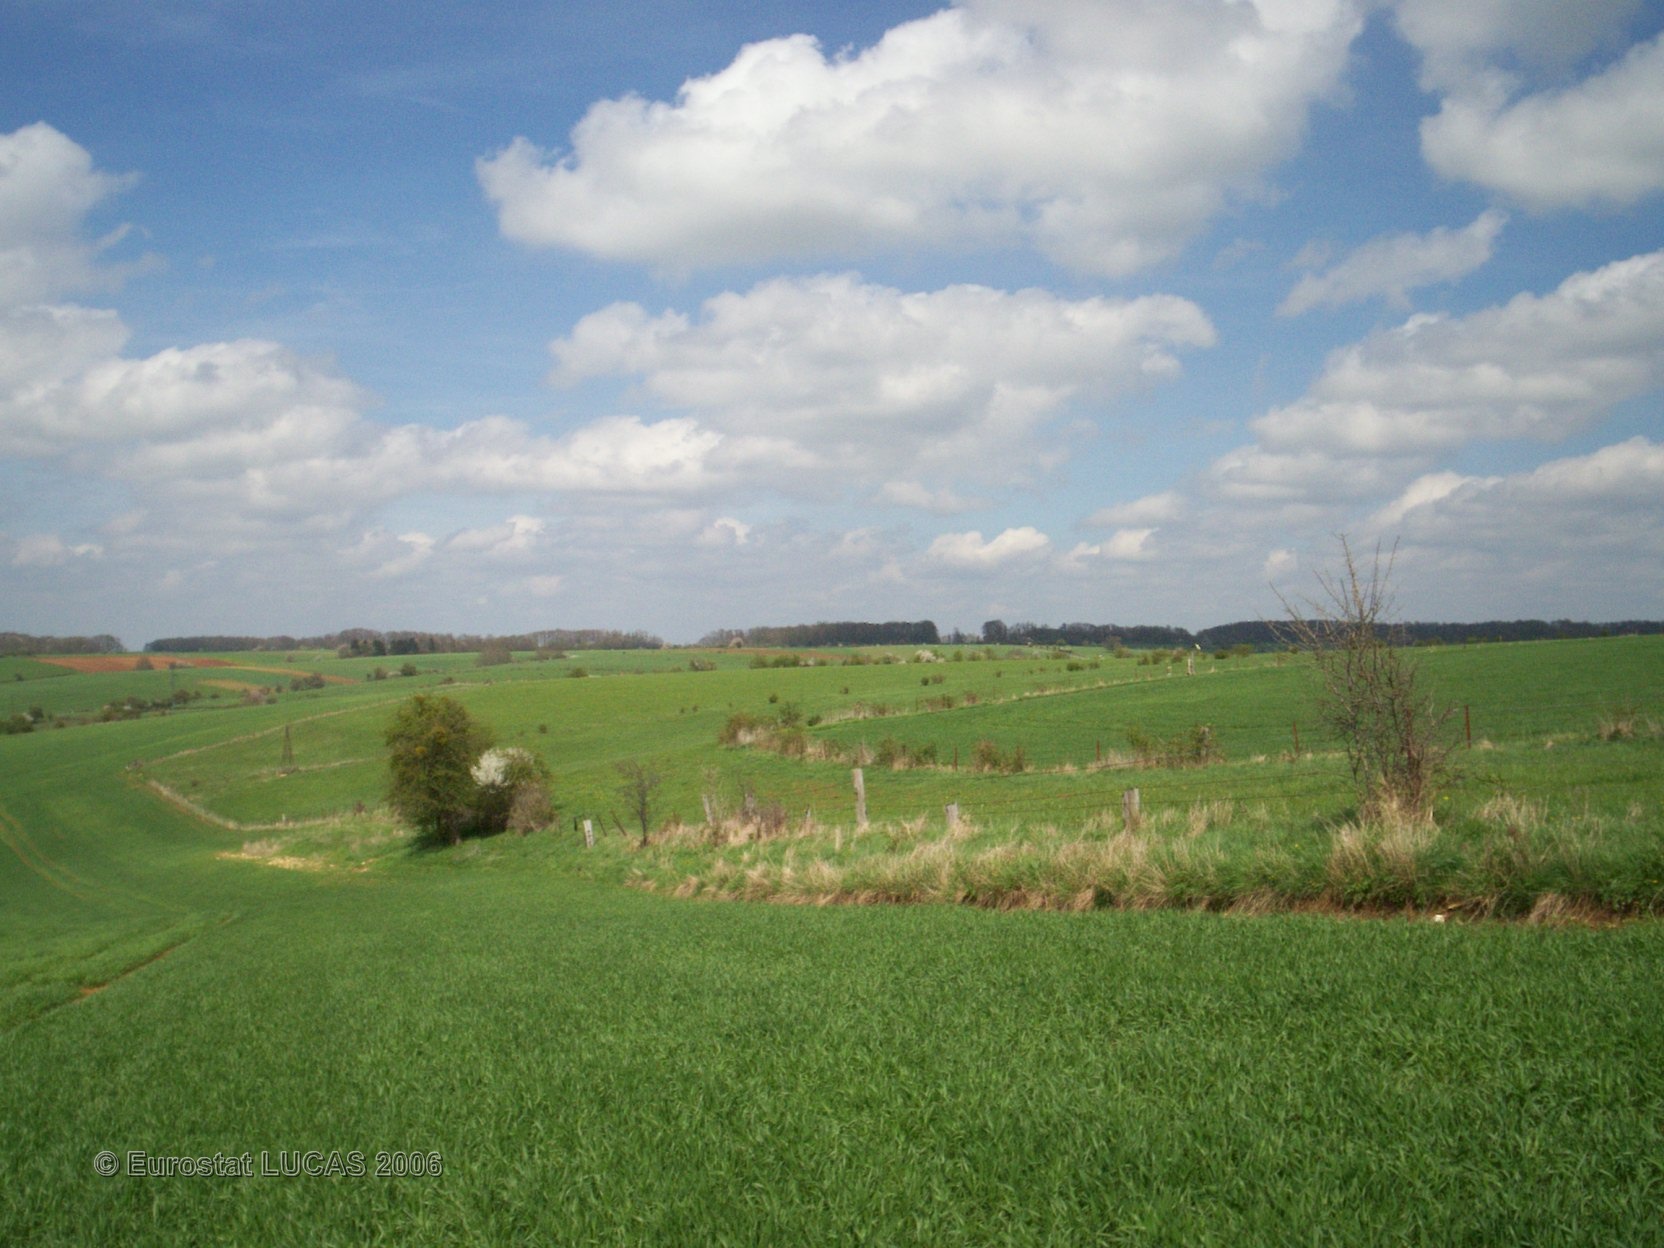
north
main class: Cropland
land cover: Common wheat
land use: Agriculture (excluding fallow land and kitchen gardens)
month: May
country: FR
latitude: 49.8121
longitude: 4.3953
